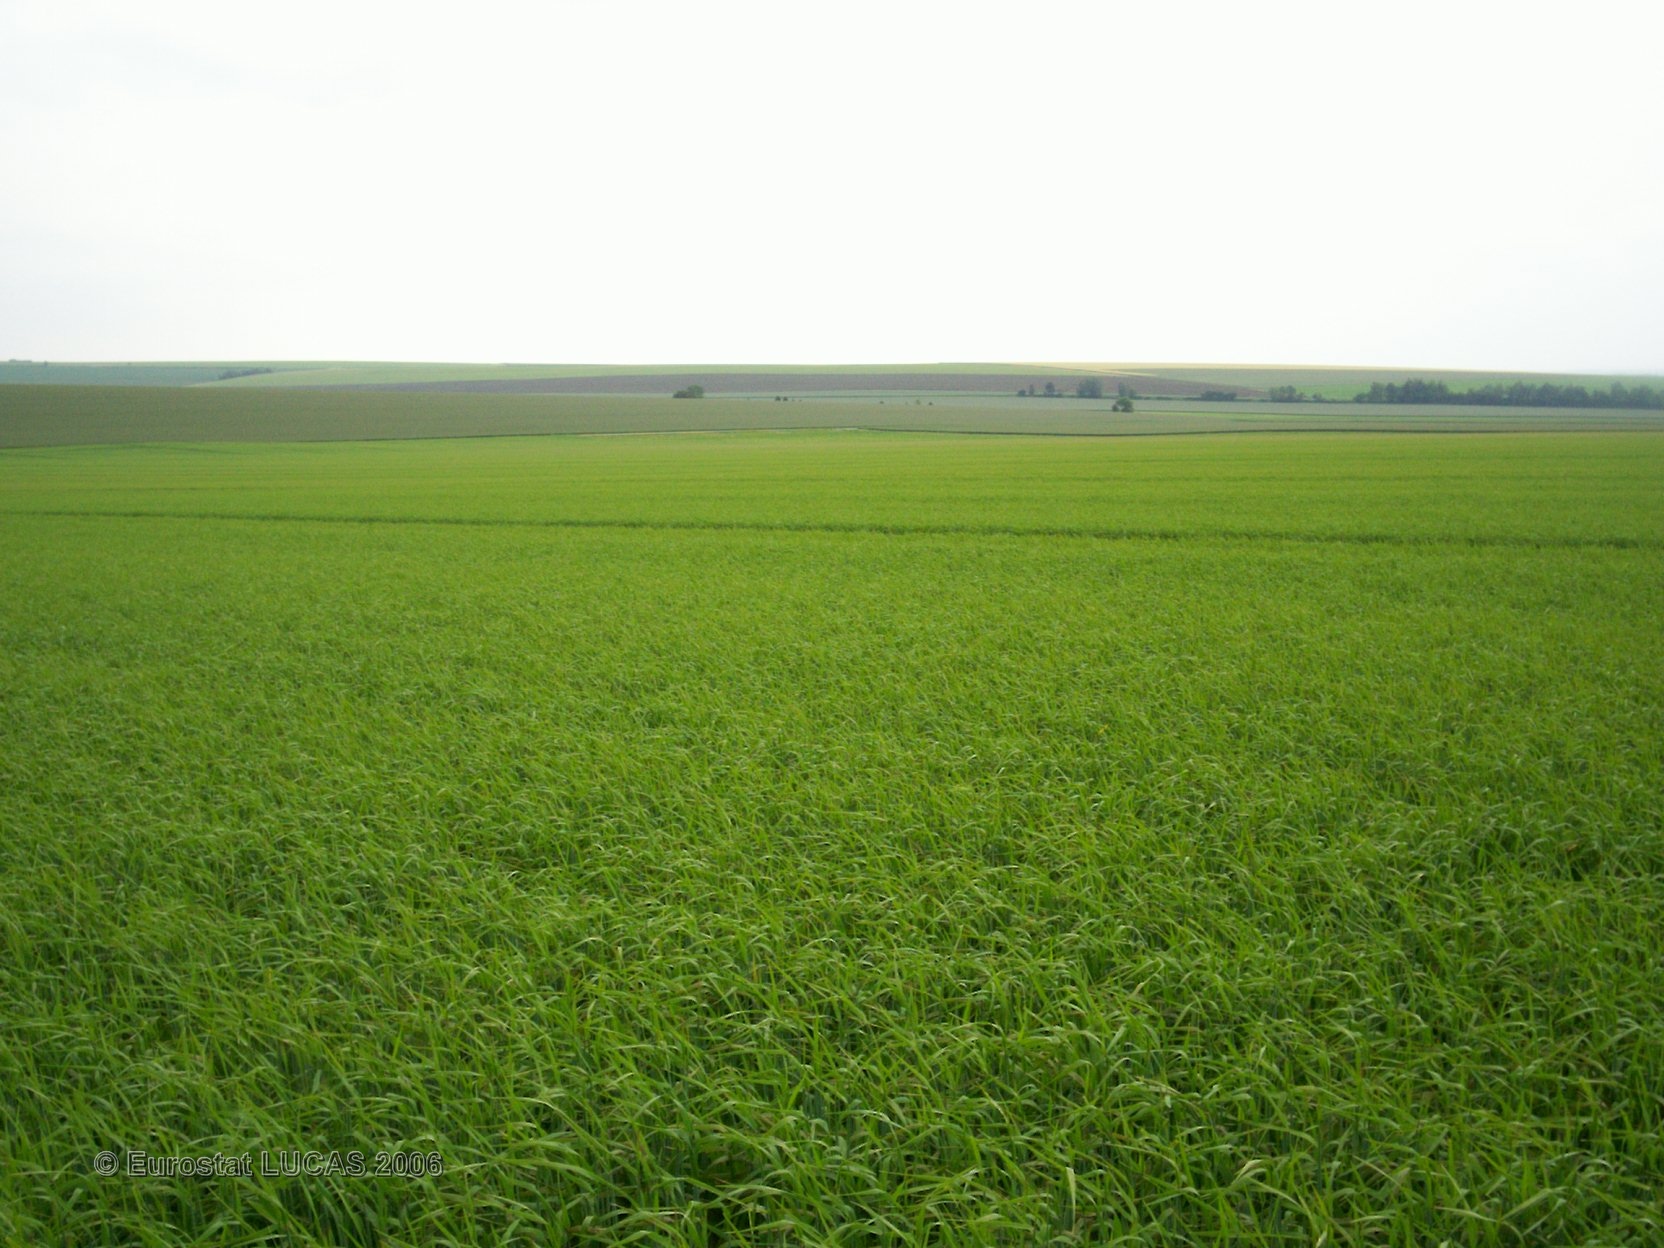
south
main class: Cropland
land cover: Barley
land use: Agriculture (excluding fallow land and kitchen gardens)
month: June
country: FR
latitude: 48.6427
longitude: 4.4460
